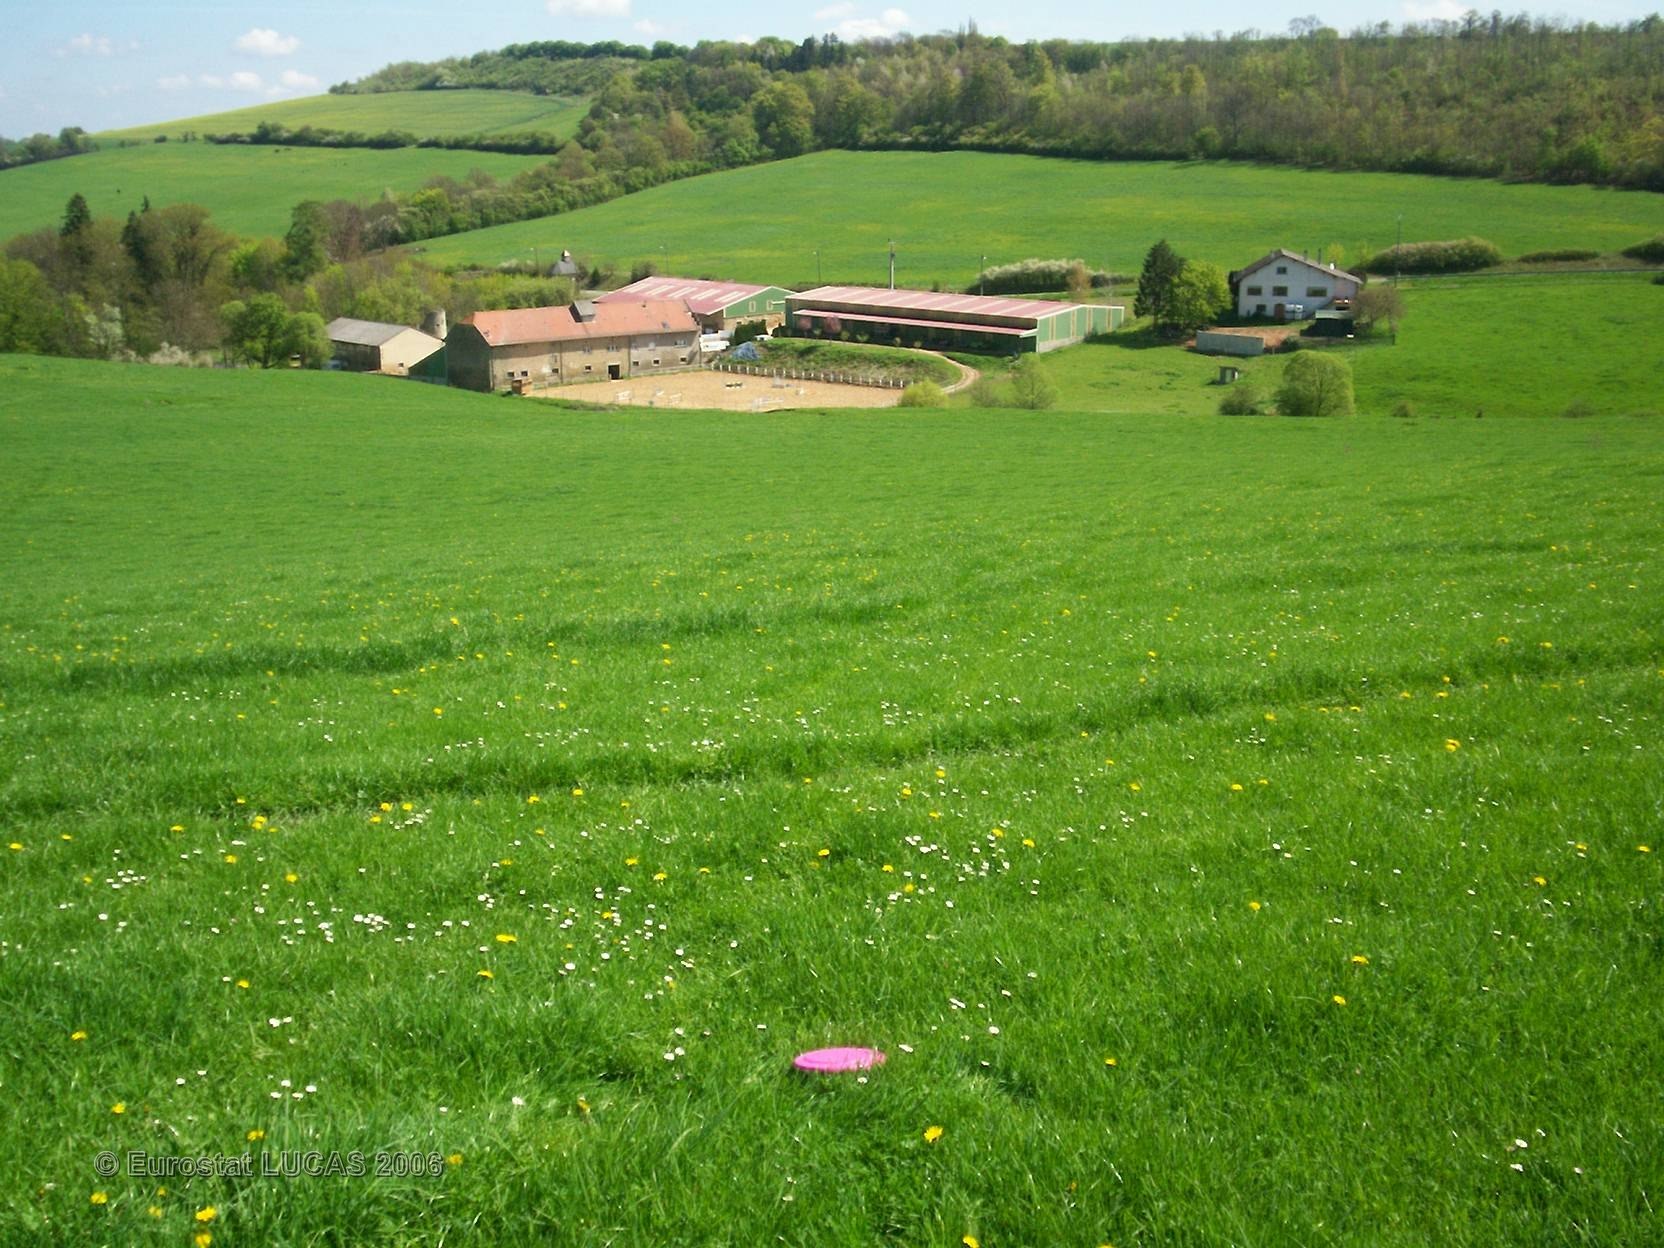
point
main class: Grassland
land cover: Grassland without tree/shrub cover
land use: Agriculture (excluding fallow land and kitchen gardens)
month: May
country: FR
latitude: 49.1129
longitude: 6.7808
